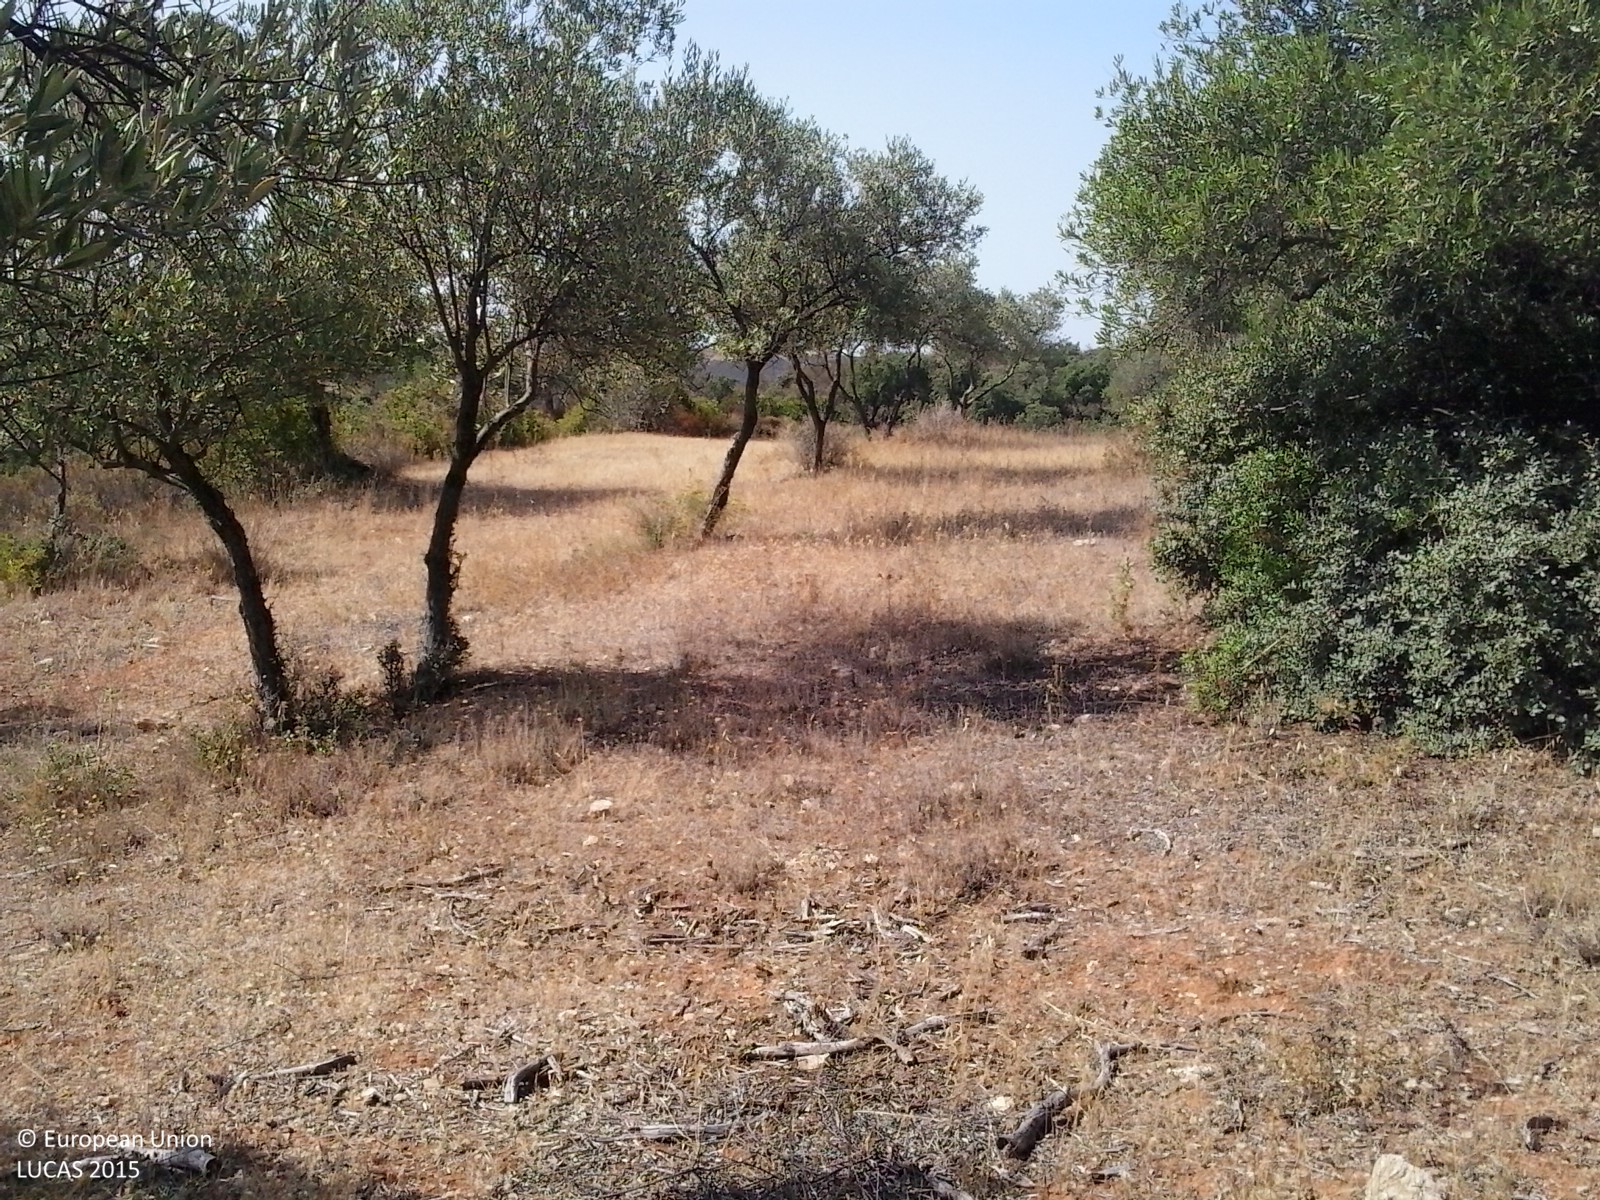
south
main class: Cropland
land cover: Olive groves
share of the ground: 25 - 50 %
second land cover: Spontaneously vegetated surfaces
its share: 50 - 75 %
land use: Agriculture (excluding fallow land and kitchen gardens)
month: July
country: ES
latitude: 37.4788
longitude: -6.4876
